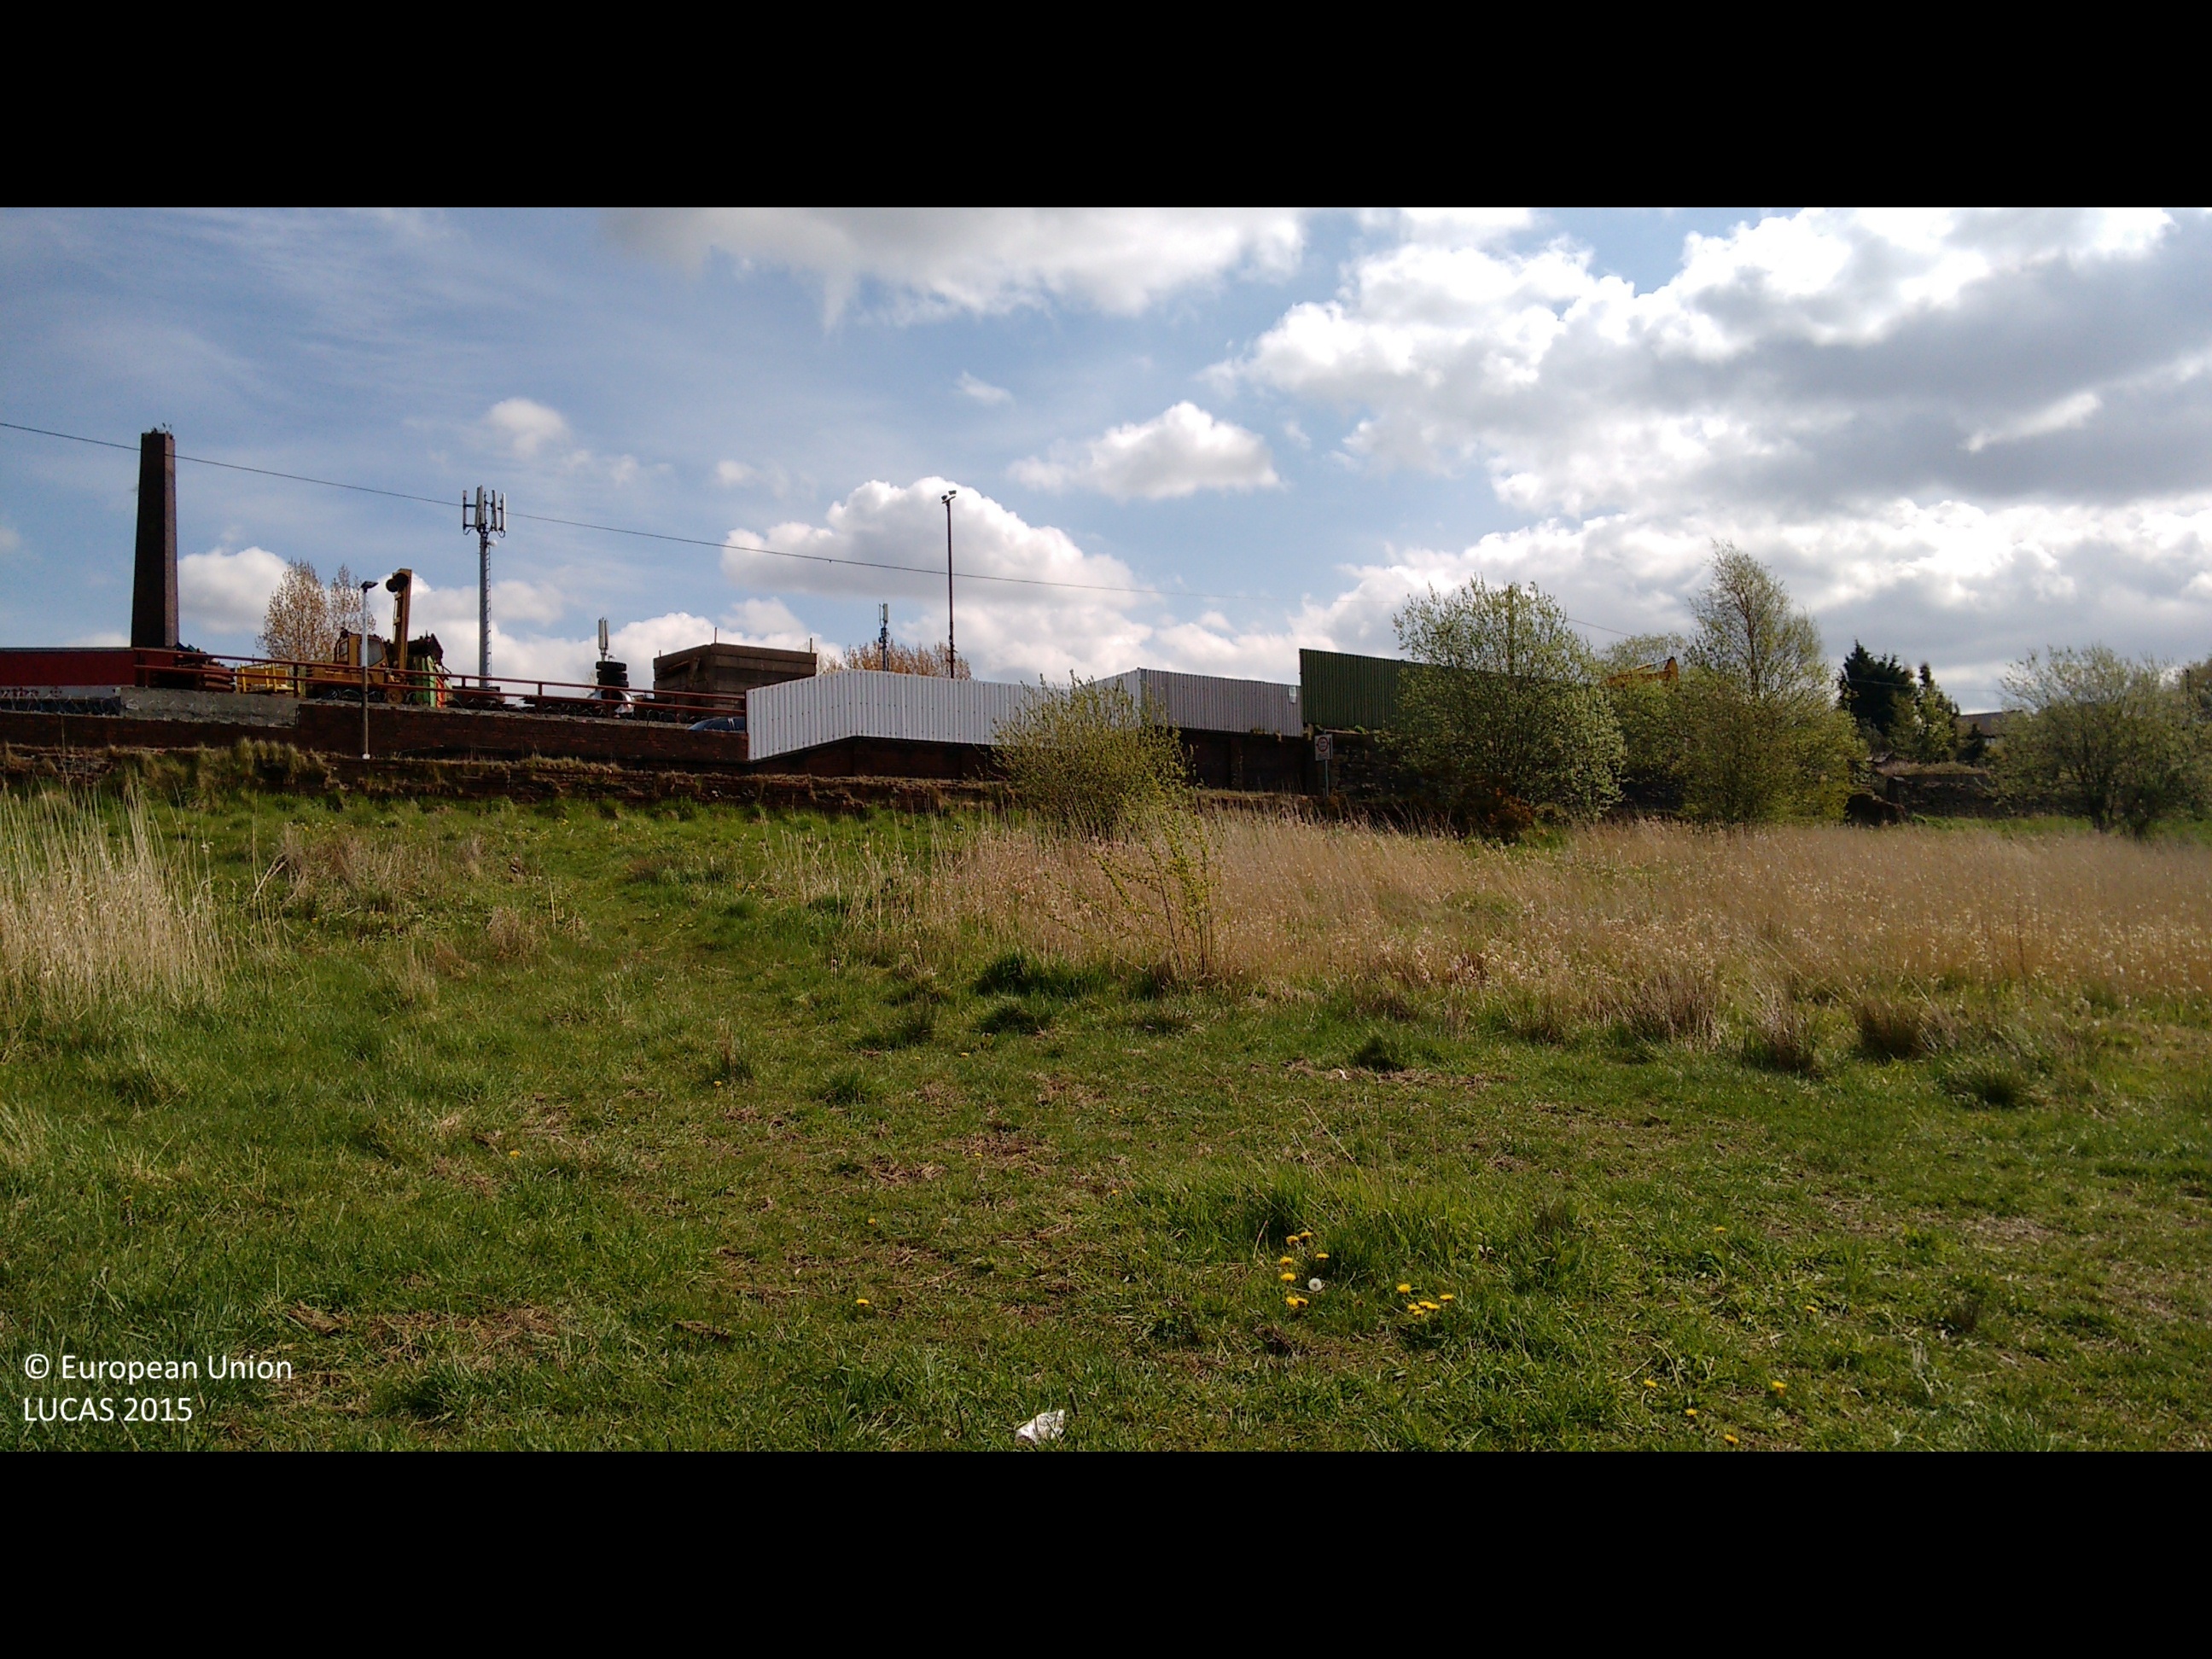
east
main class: Grassland
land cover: Grassland without tree/shrub cover
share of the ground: > 75 %
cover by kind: herbaceous plants 100 %
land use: Semi-natural and natural areas not in use
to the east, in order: Grassland without tree/shrub cover; Artificial constructions in urban areas; Railways; Artificial constructions in urban areas
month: May
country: GB
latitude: 53.7008
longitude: -2.4702
